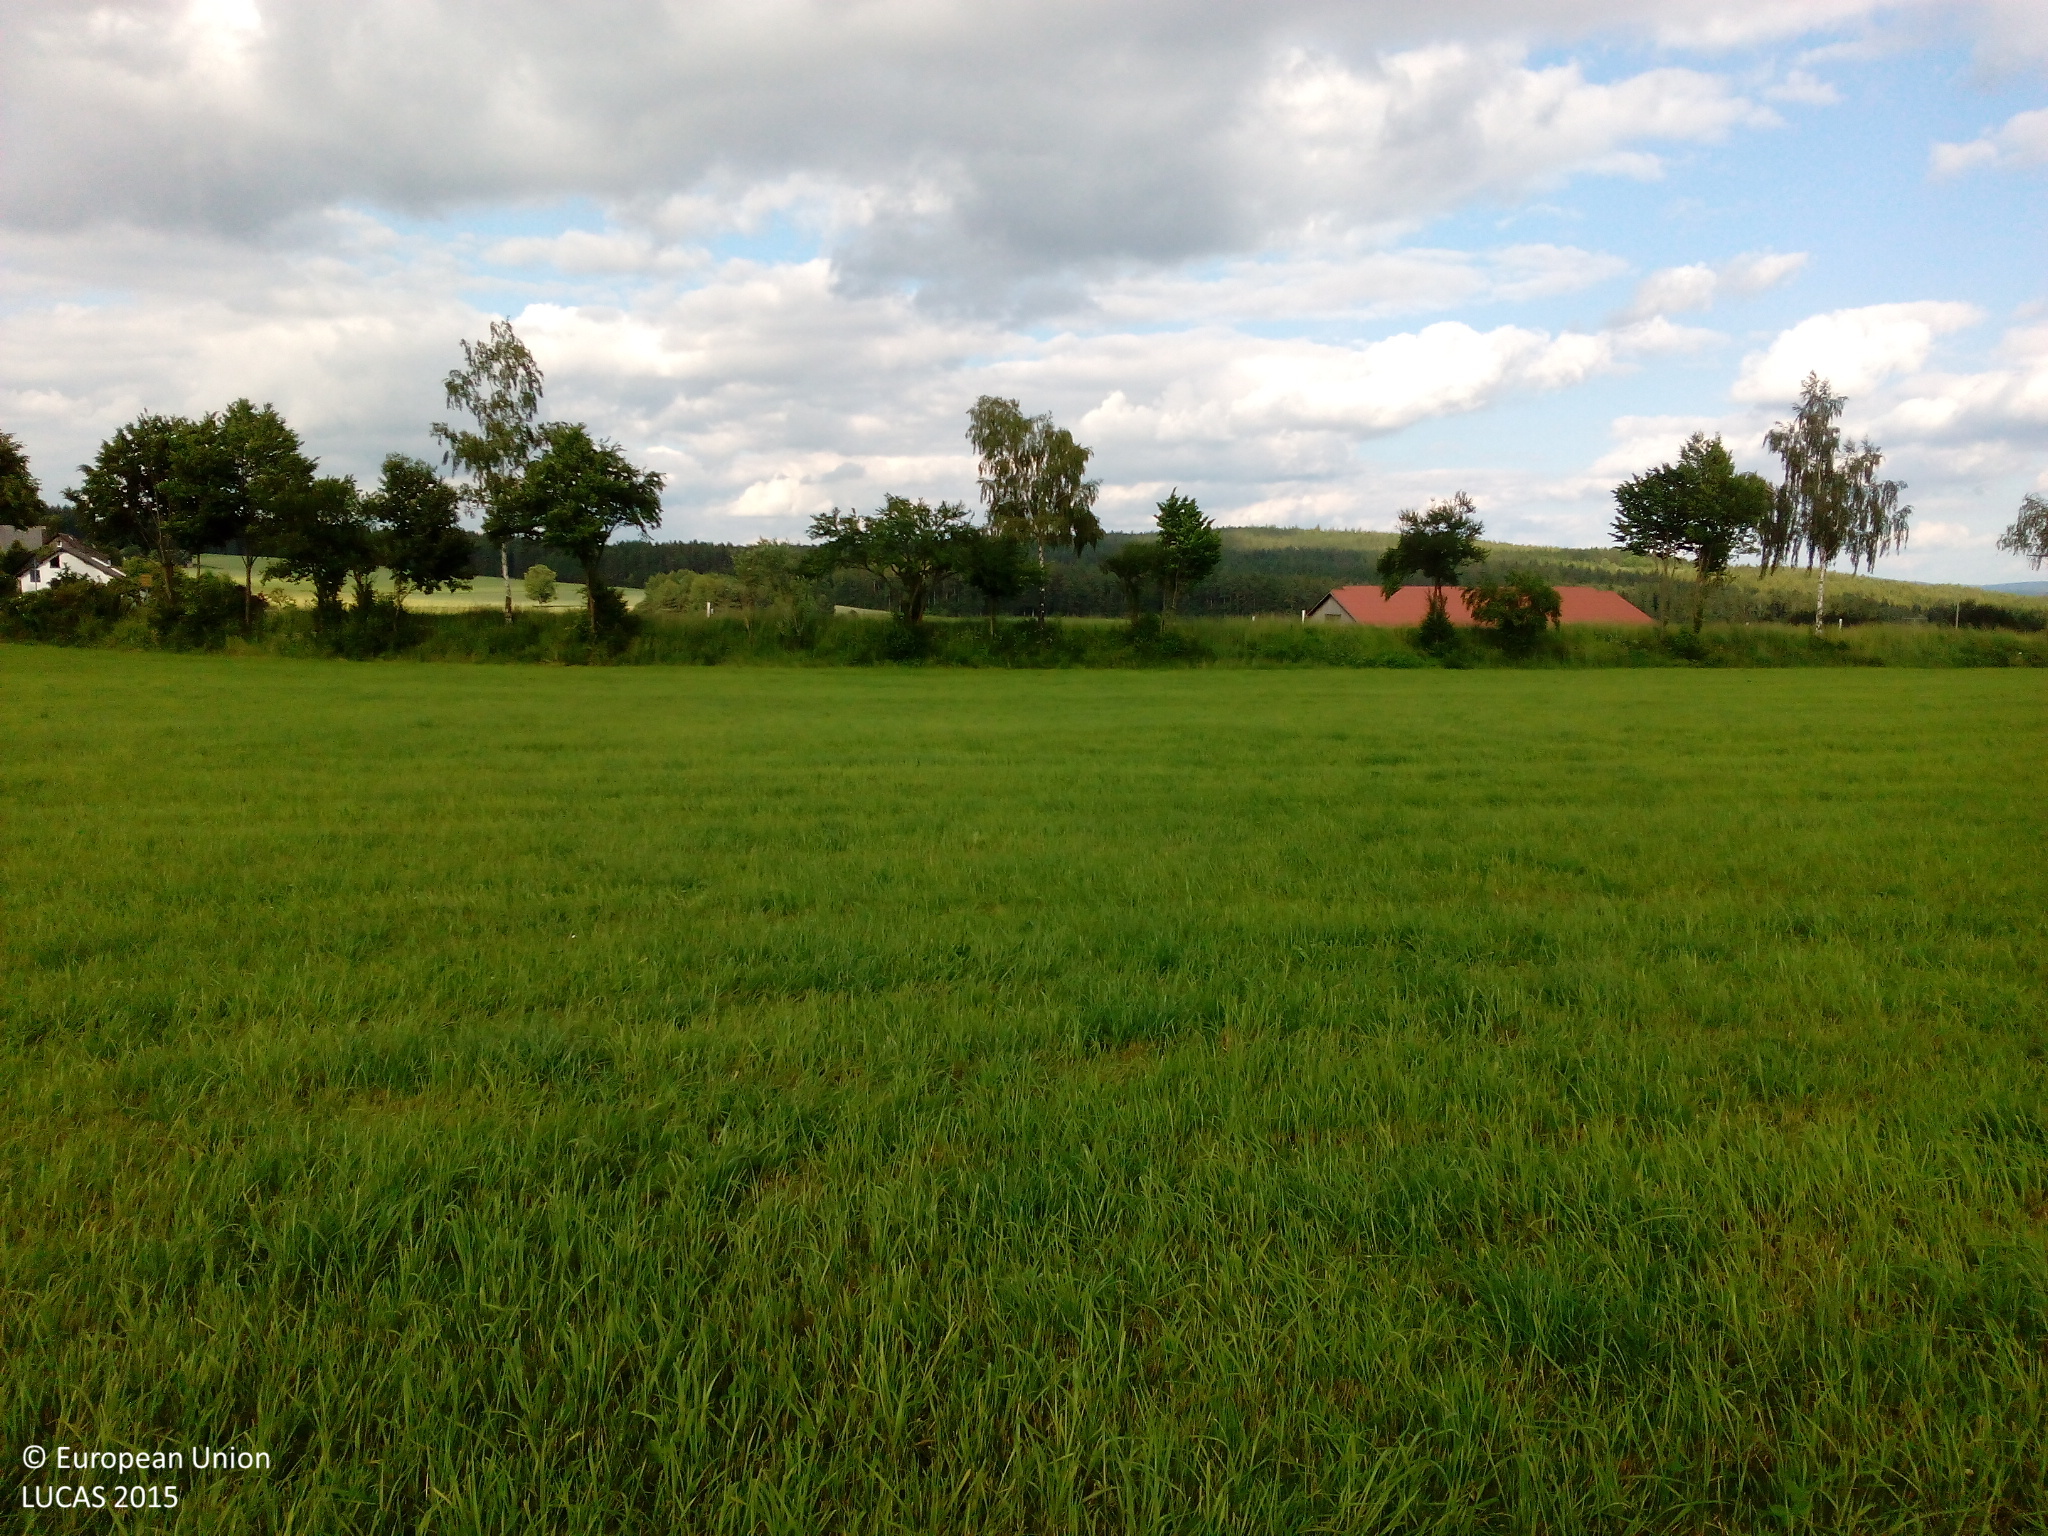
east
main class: Grassland
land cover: Grassland without tree/shrub cover
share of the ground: > 75 %
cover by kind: herbaceous plants 95 %, unconsolidated bare surface 5 %
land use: Agriculture (excluding fallow land and kitchen gardens)
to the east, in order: Grassland without tree/shrub cover; Lines of trees; Paved roads, cycling and walking lanes; Grassland without tree/shrub cover
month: June
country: DE
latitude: 50.0182
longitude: 12.2466
